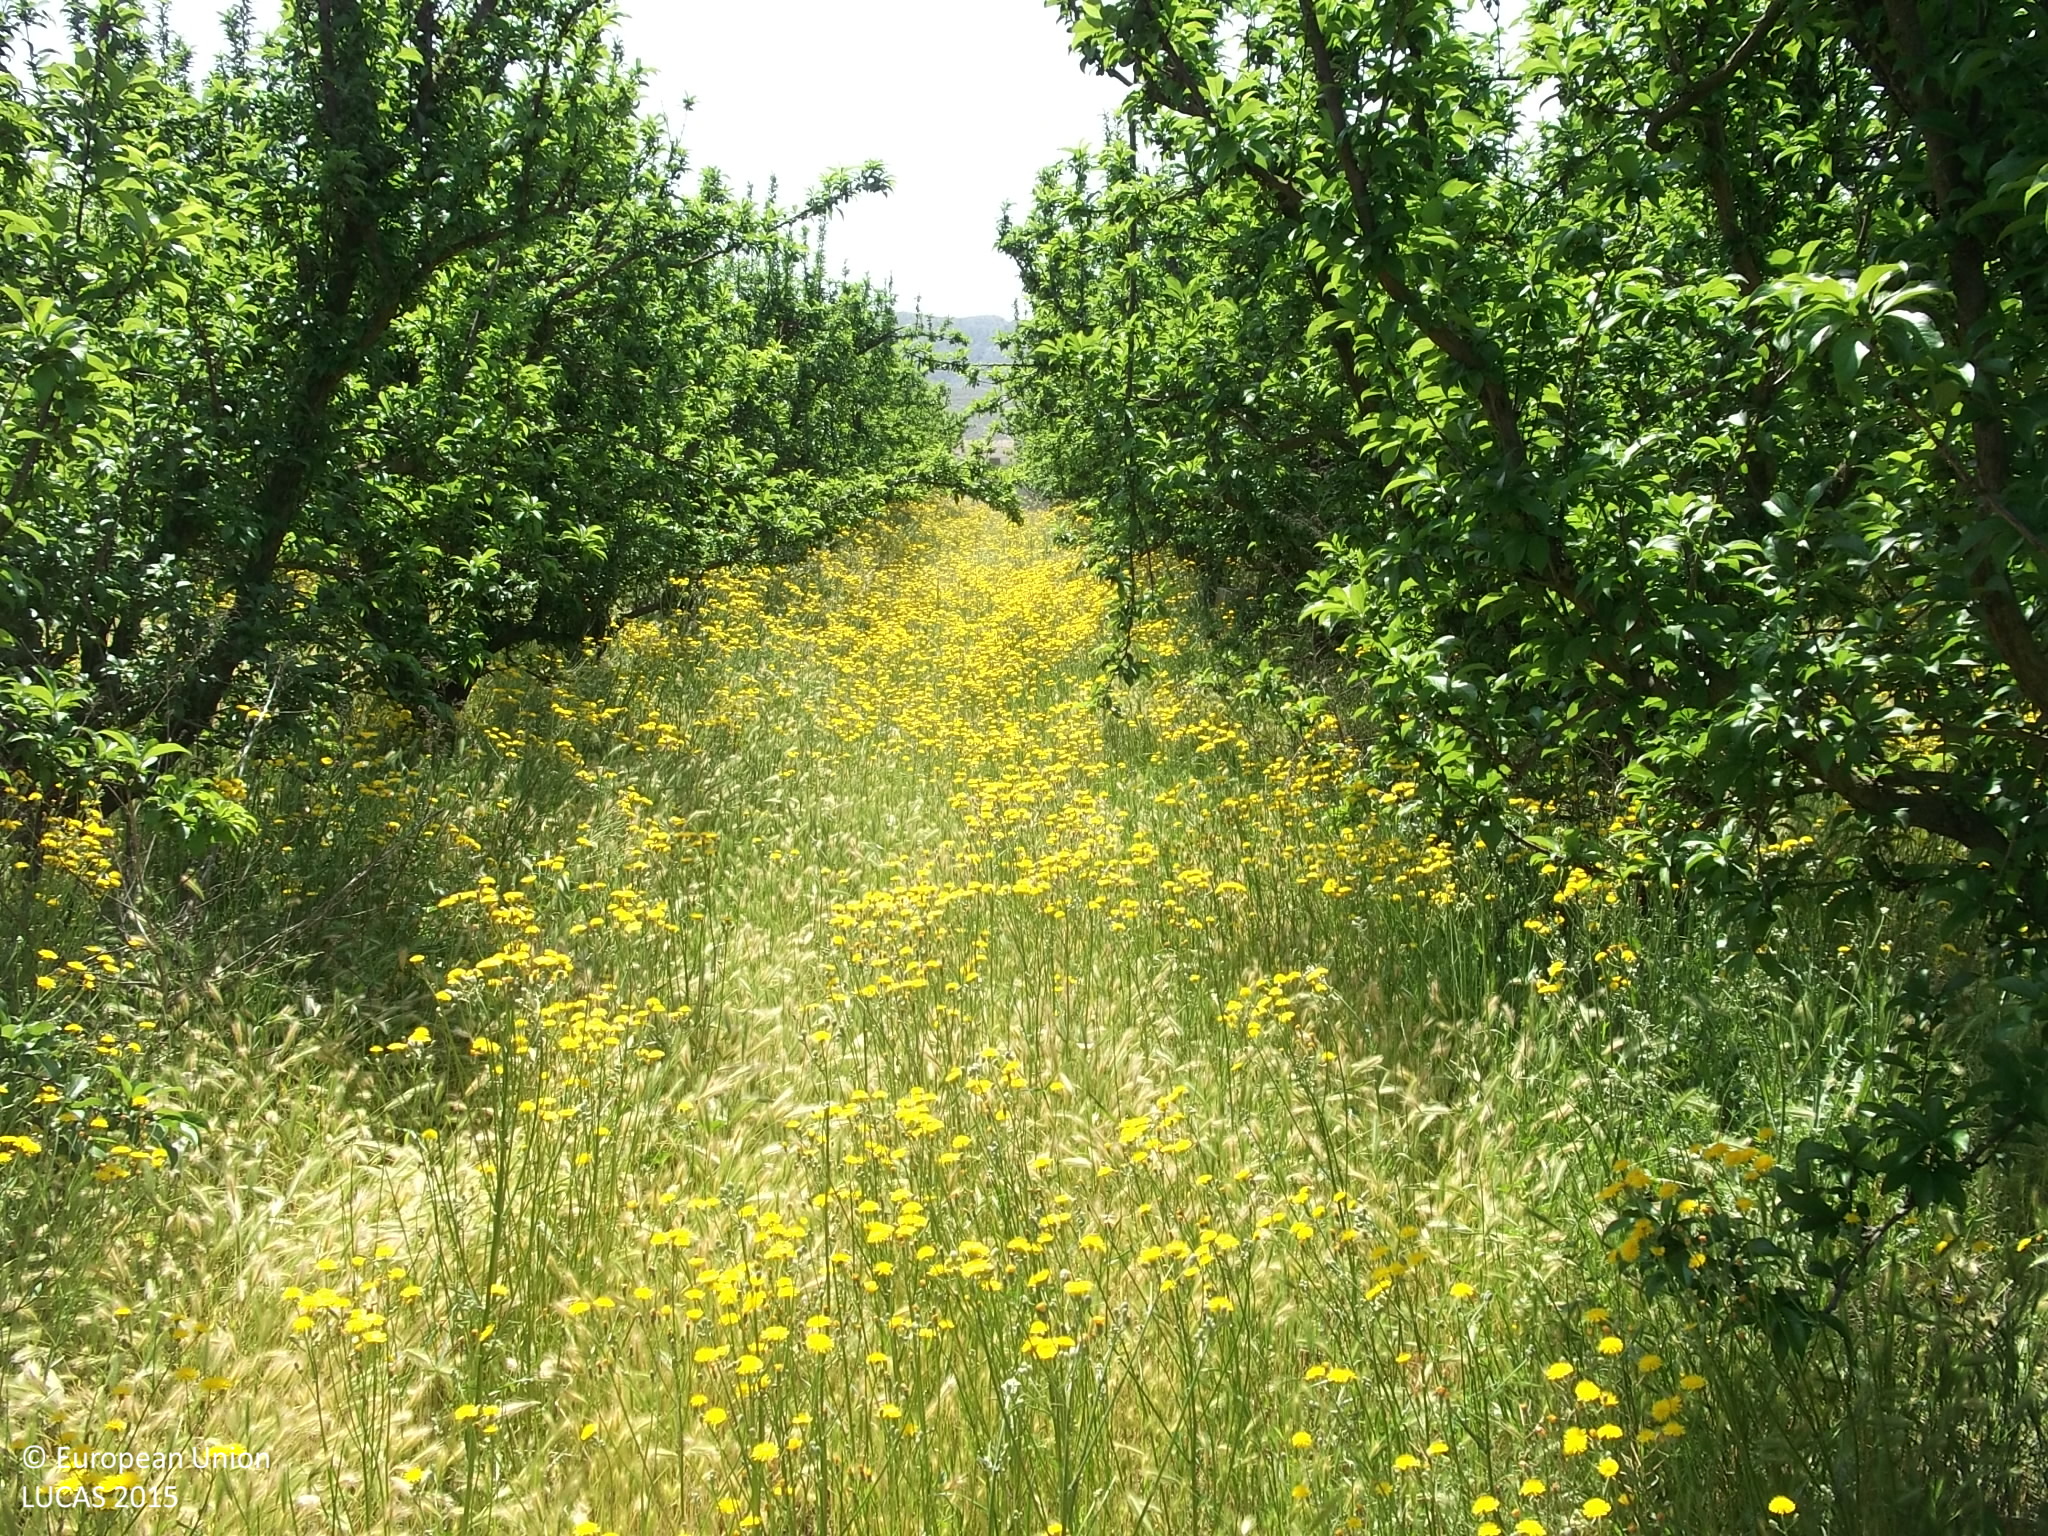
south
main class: Cropland
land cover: Other fruit trees and berries
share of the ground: 25 - 50 %
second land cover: Spontaneously vegetated surfaces
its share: 50 - 75 %
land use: Agriculture (excluding fallow land and kitchen gardens)
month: April
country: ES
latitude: 38.2595
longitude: -1.6124
